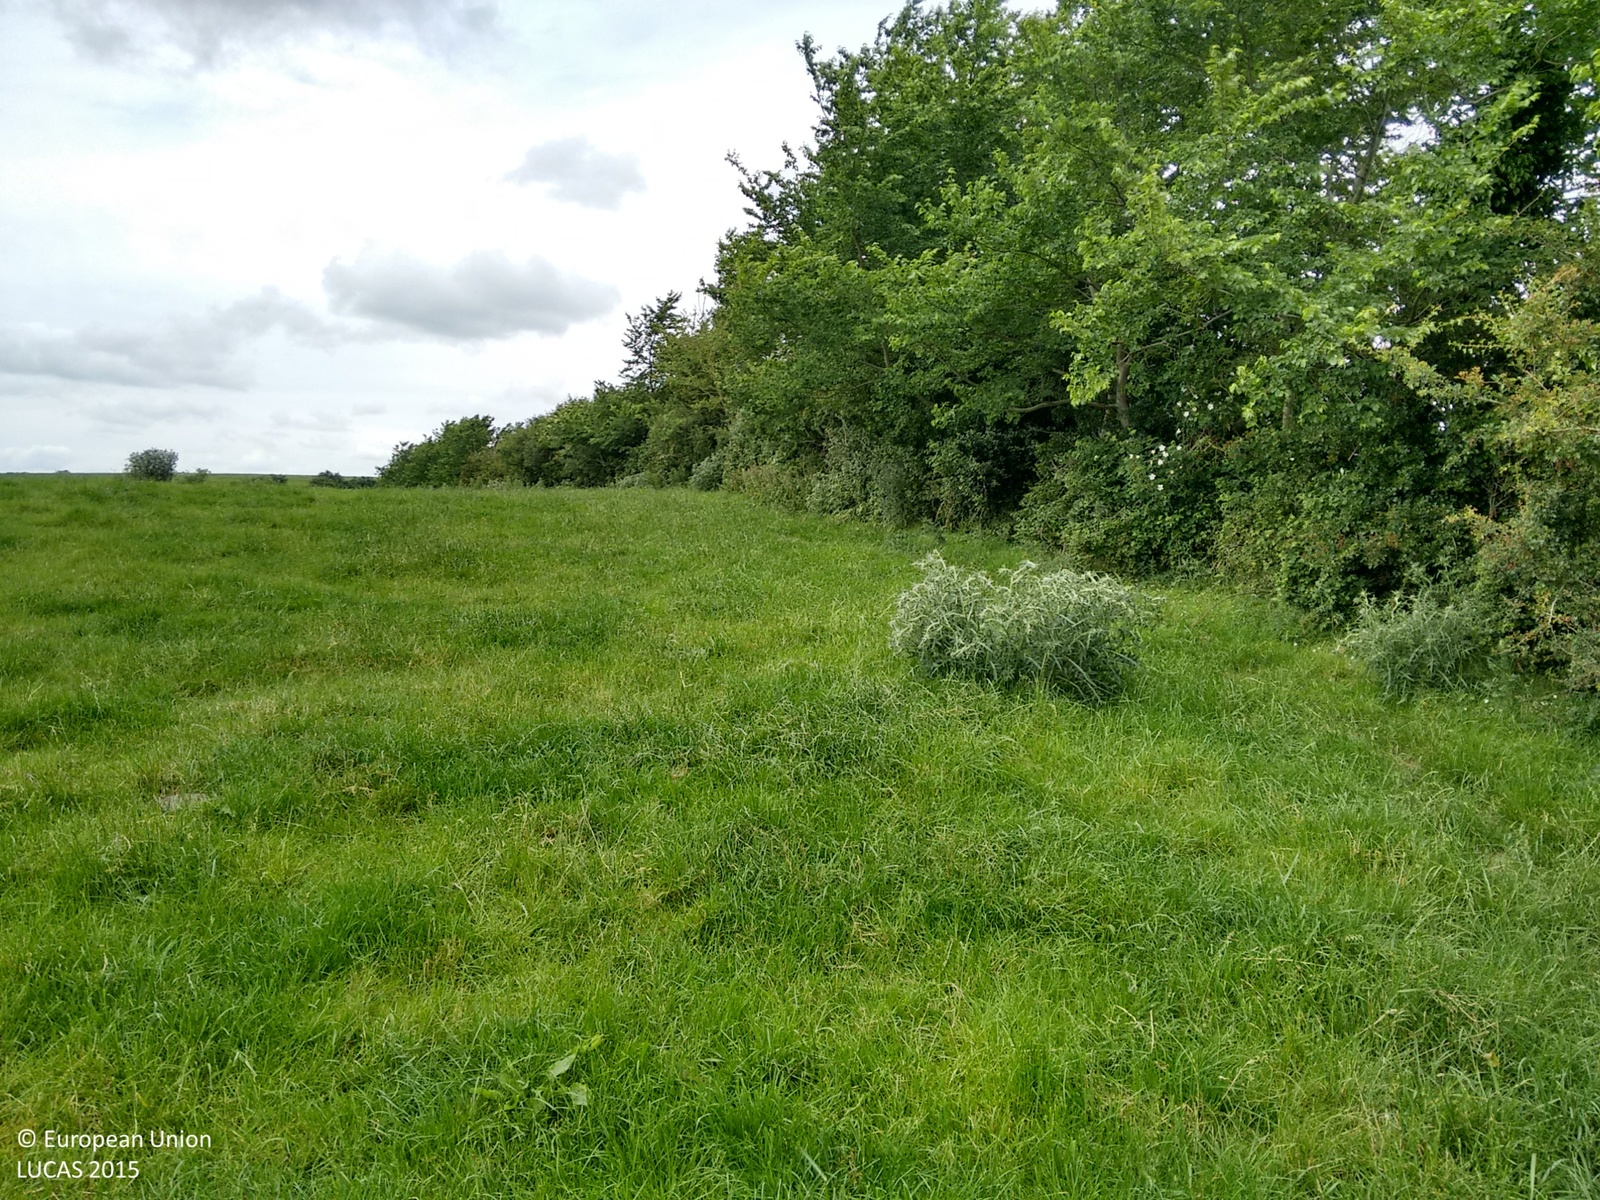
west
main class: Grassland
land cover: Grassland without tree/shrub cover
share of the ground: > 75 %
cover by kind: herbaceous plants 100 %
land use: Agriculture (excluding fallow land and kitchen gardens)
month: July
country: IE
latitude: 53.8719
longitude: -6.6629
